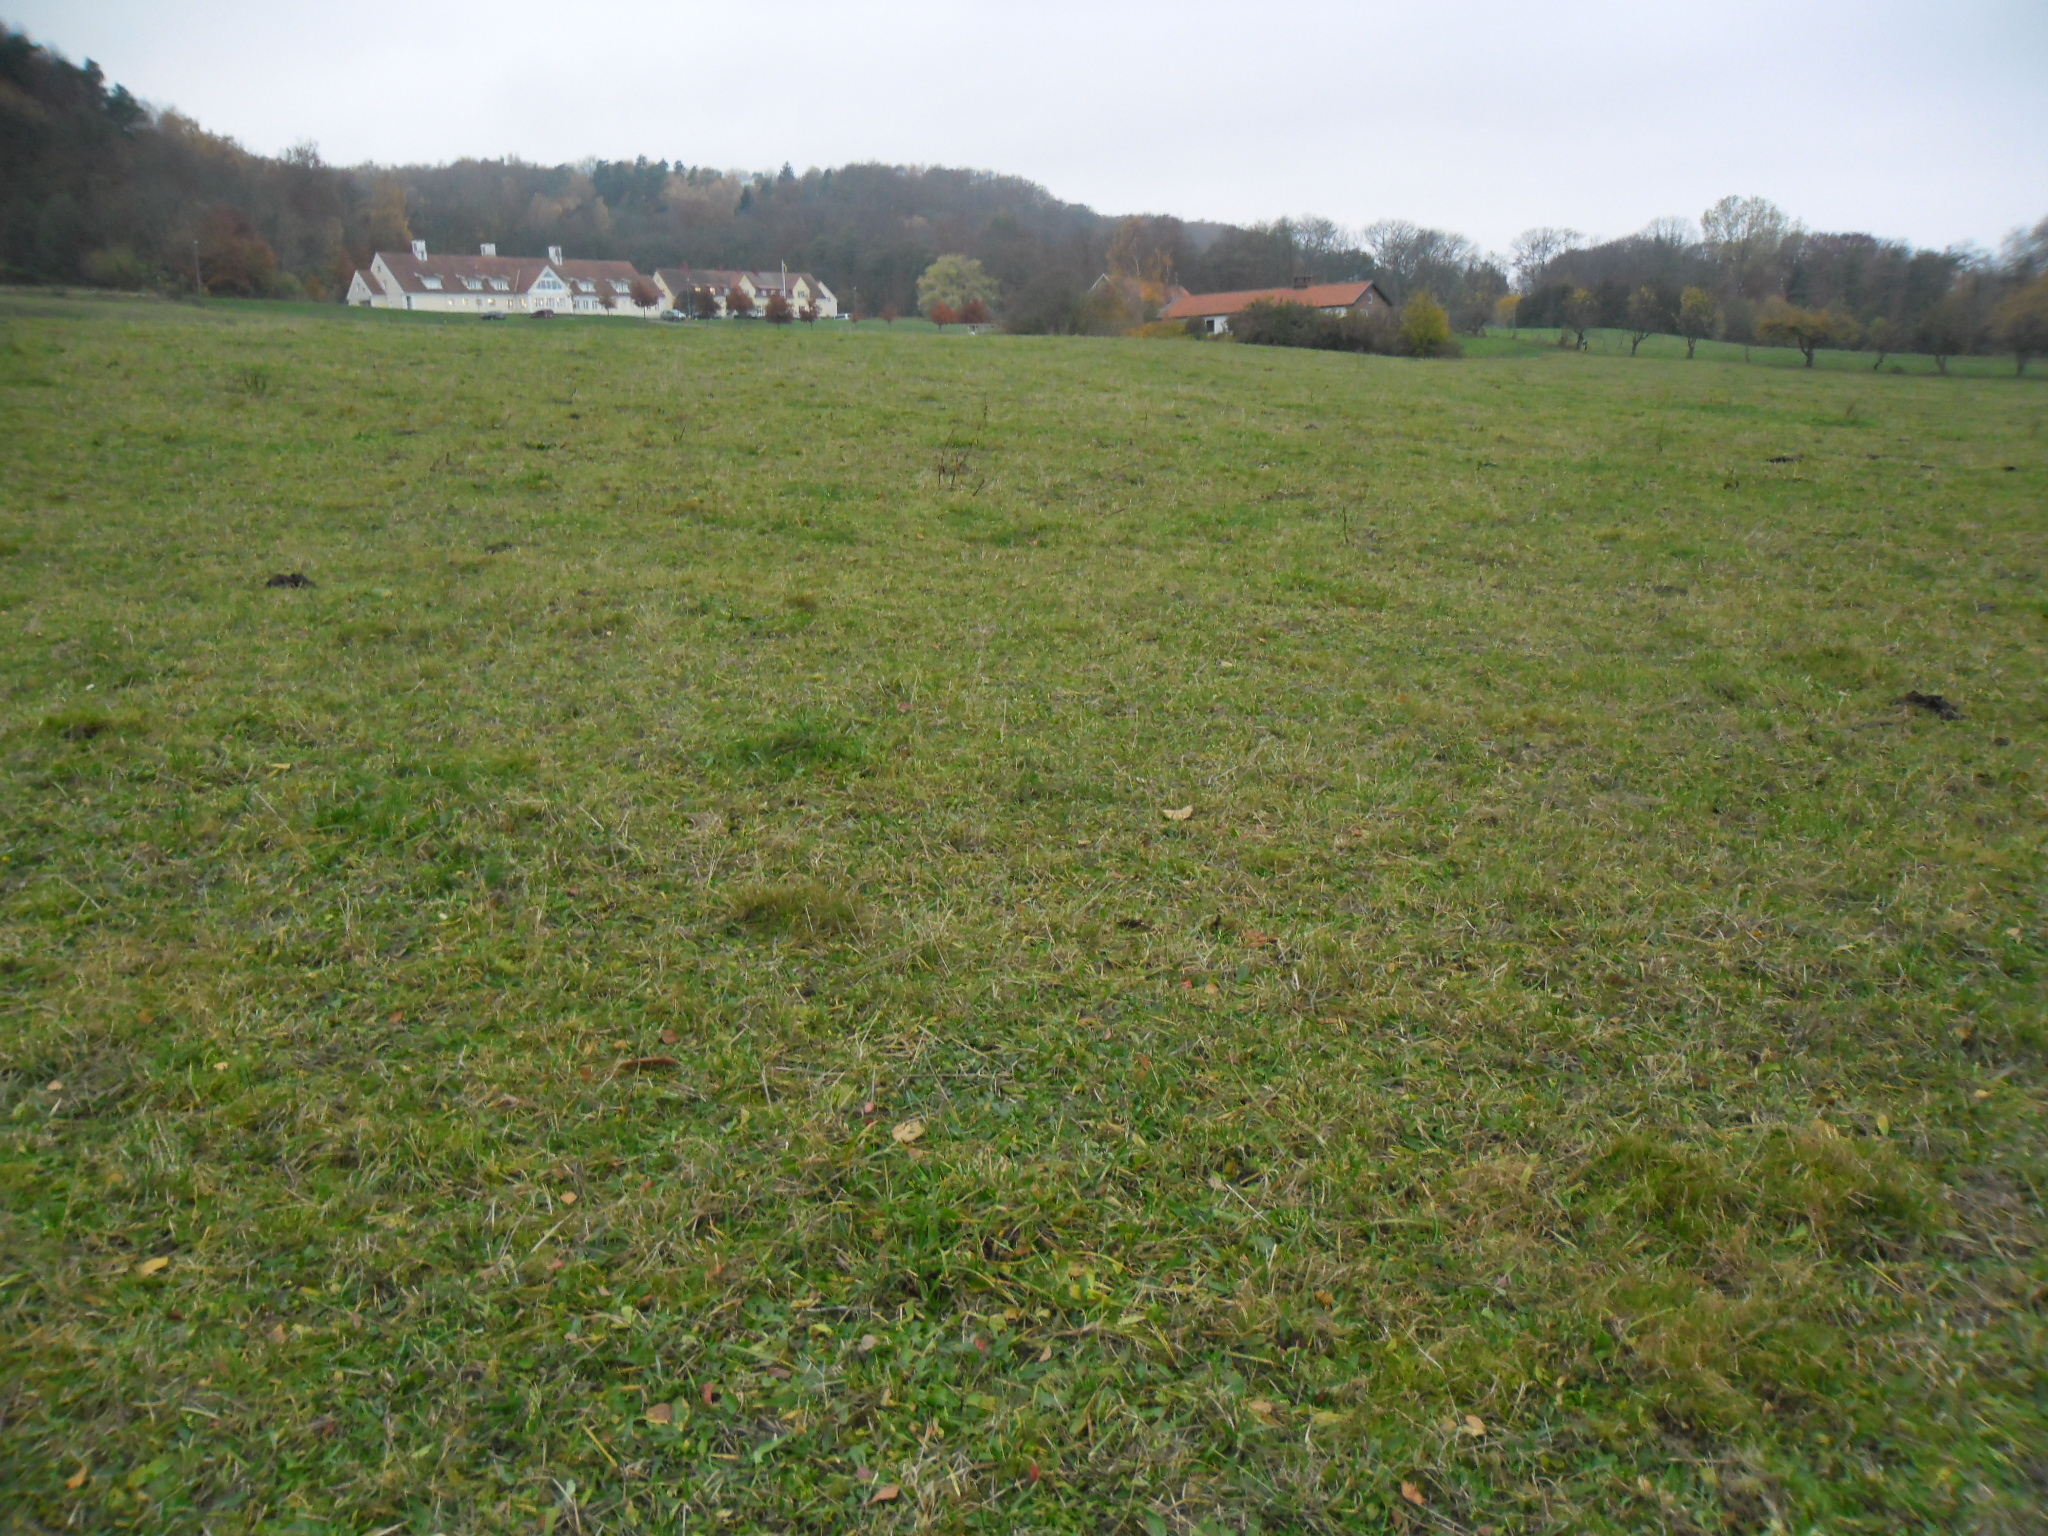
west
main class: Grassland
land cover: Grassland without tree/shrub cover
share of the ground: > 75 %
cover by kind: herbaceous plants 100 %
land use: Agriculture (excluding fallow land and kitchen gardens)
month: November
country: SE
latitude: 56.4450
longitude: 12.8036
